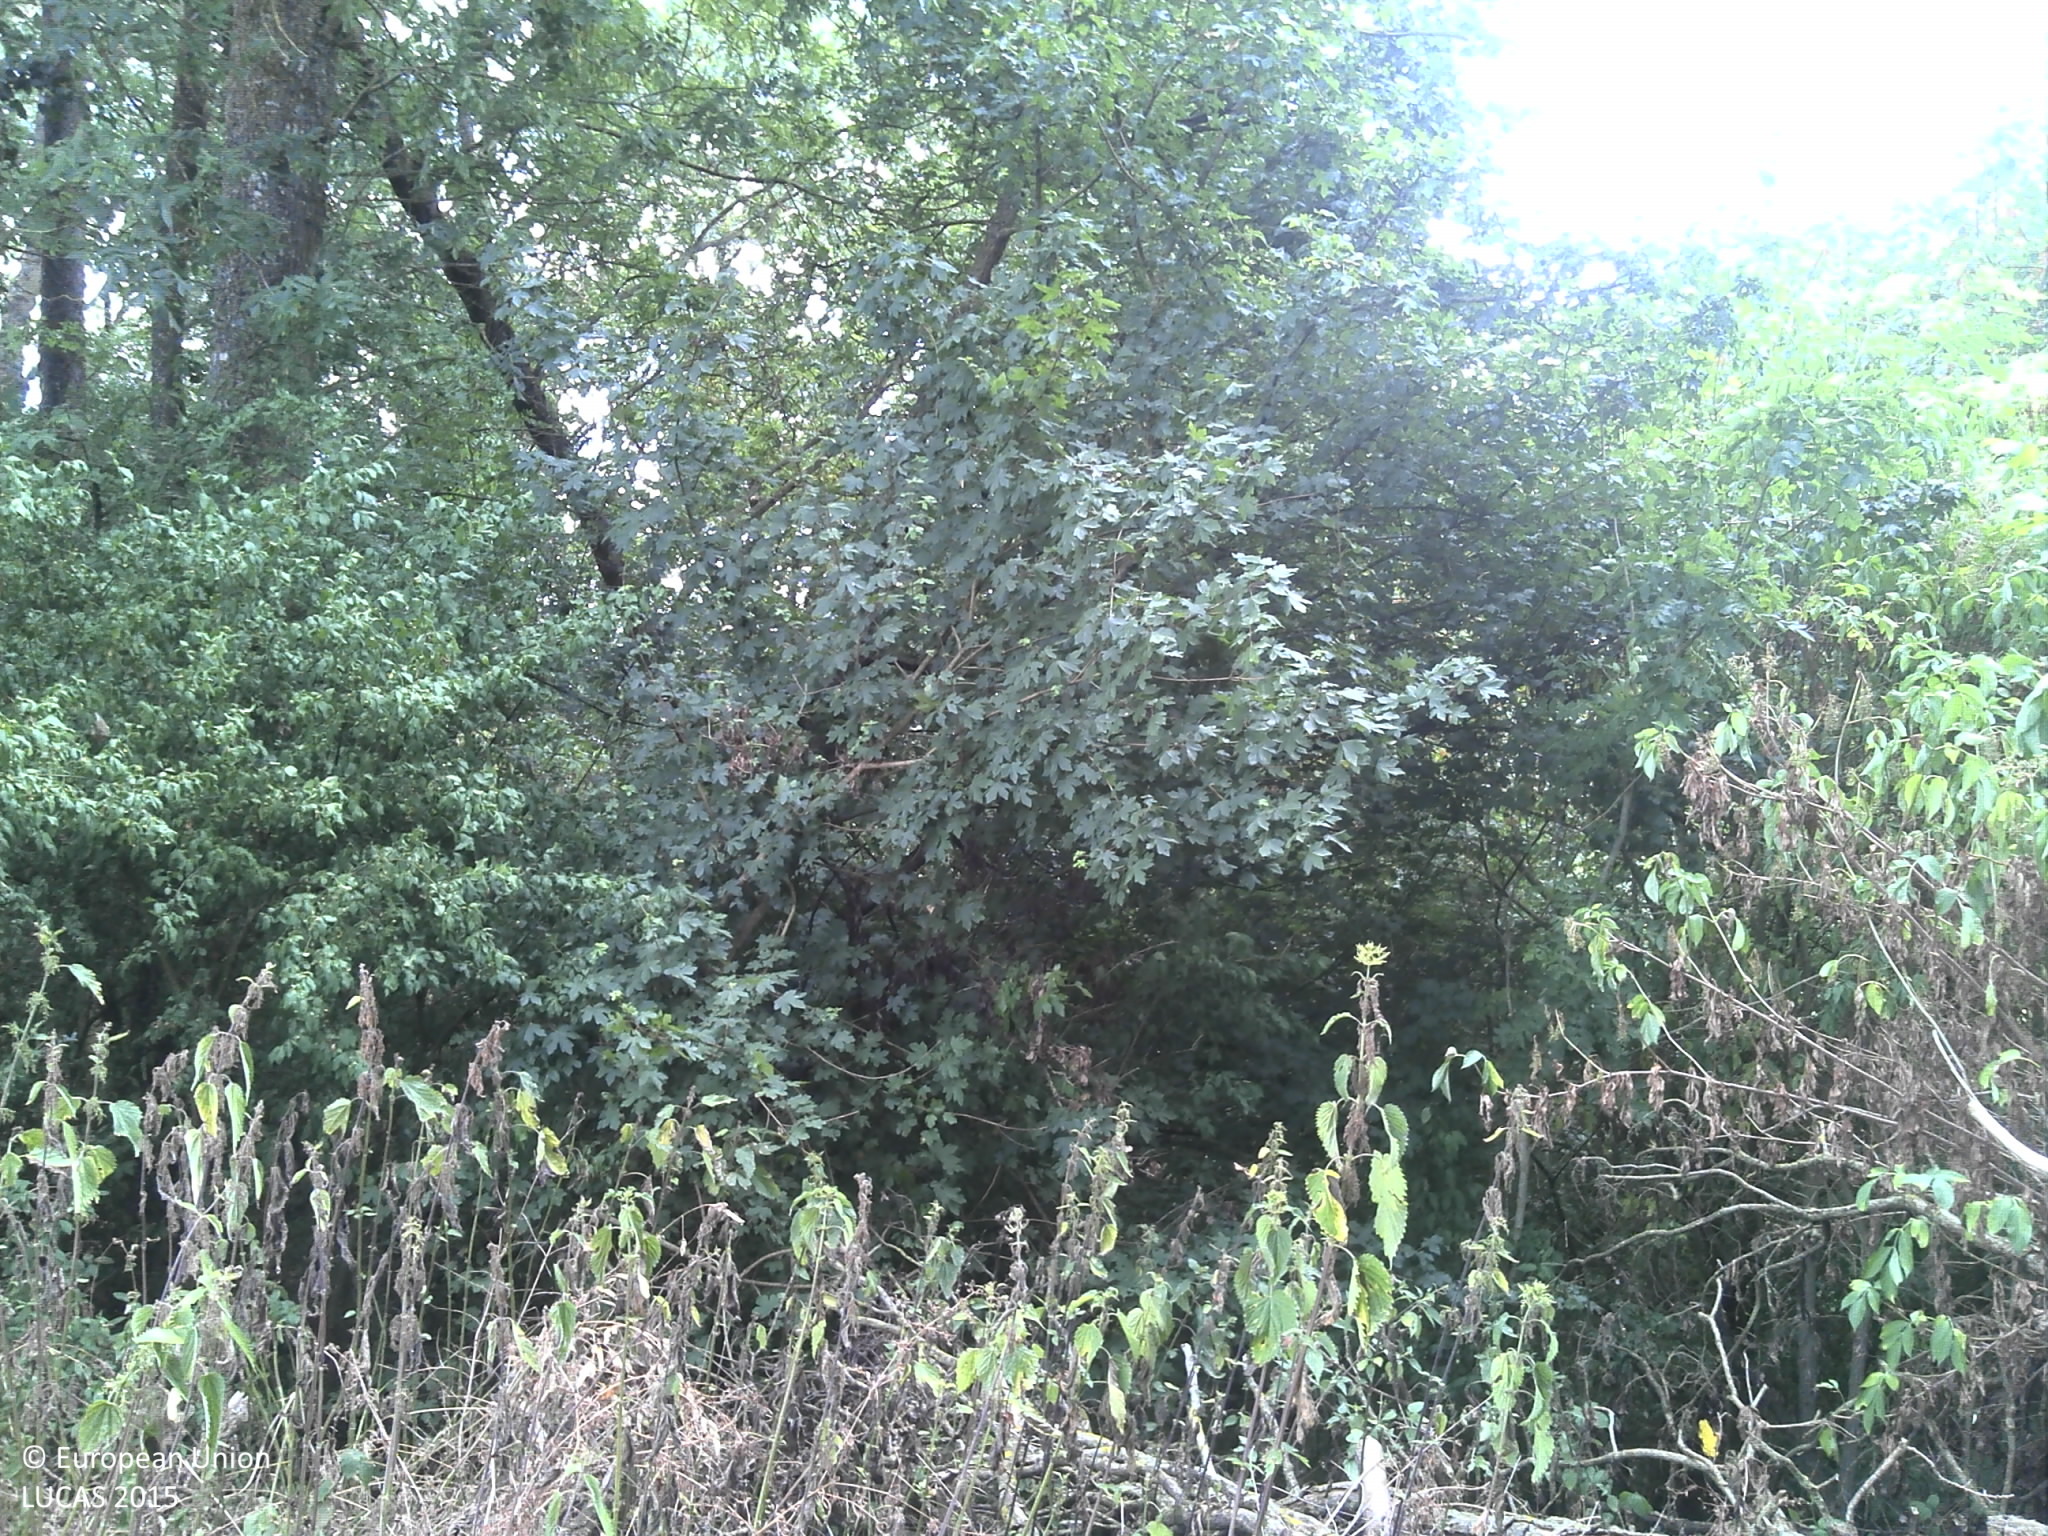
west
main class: Woodland
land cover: Broadleaved woodland
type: acidophilous oak and oak-birch forest
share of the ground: 50 - 75 %
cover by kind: broadleaved forest trees 70 %, herbaceous plants 20 %, consolidated bare surface 10 %
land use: Forestry
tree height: > 5 m
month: July
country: FR
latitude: 49.3259
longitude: 4.7824
